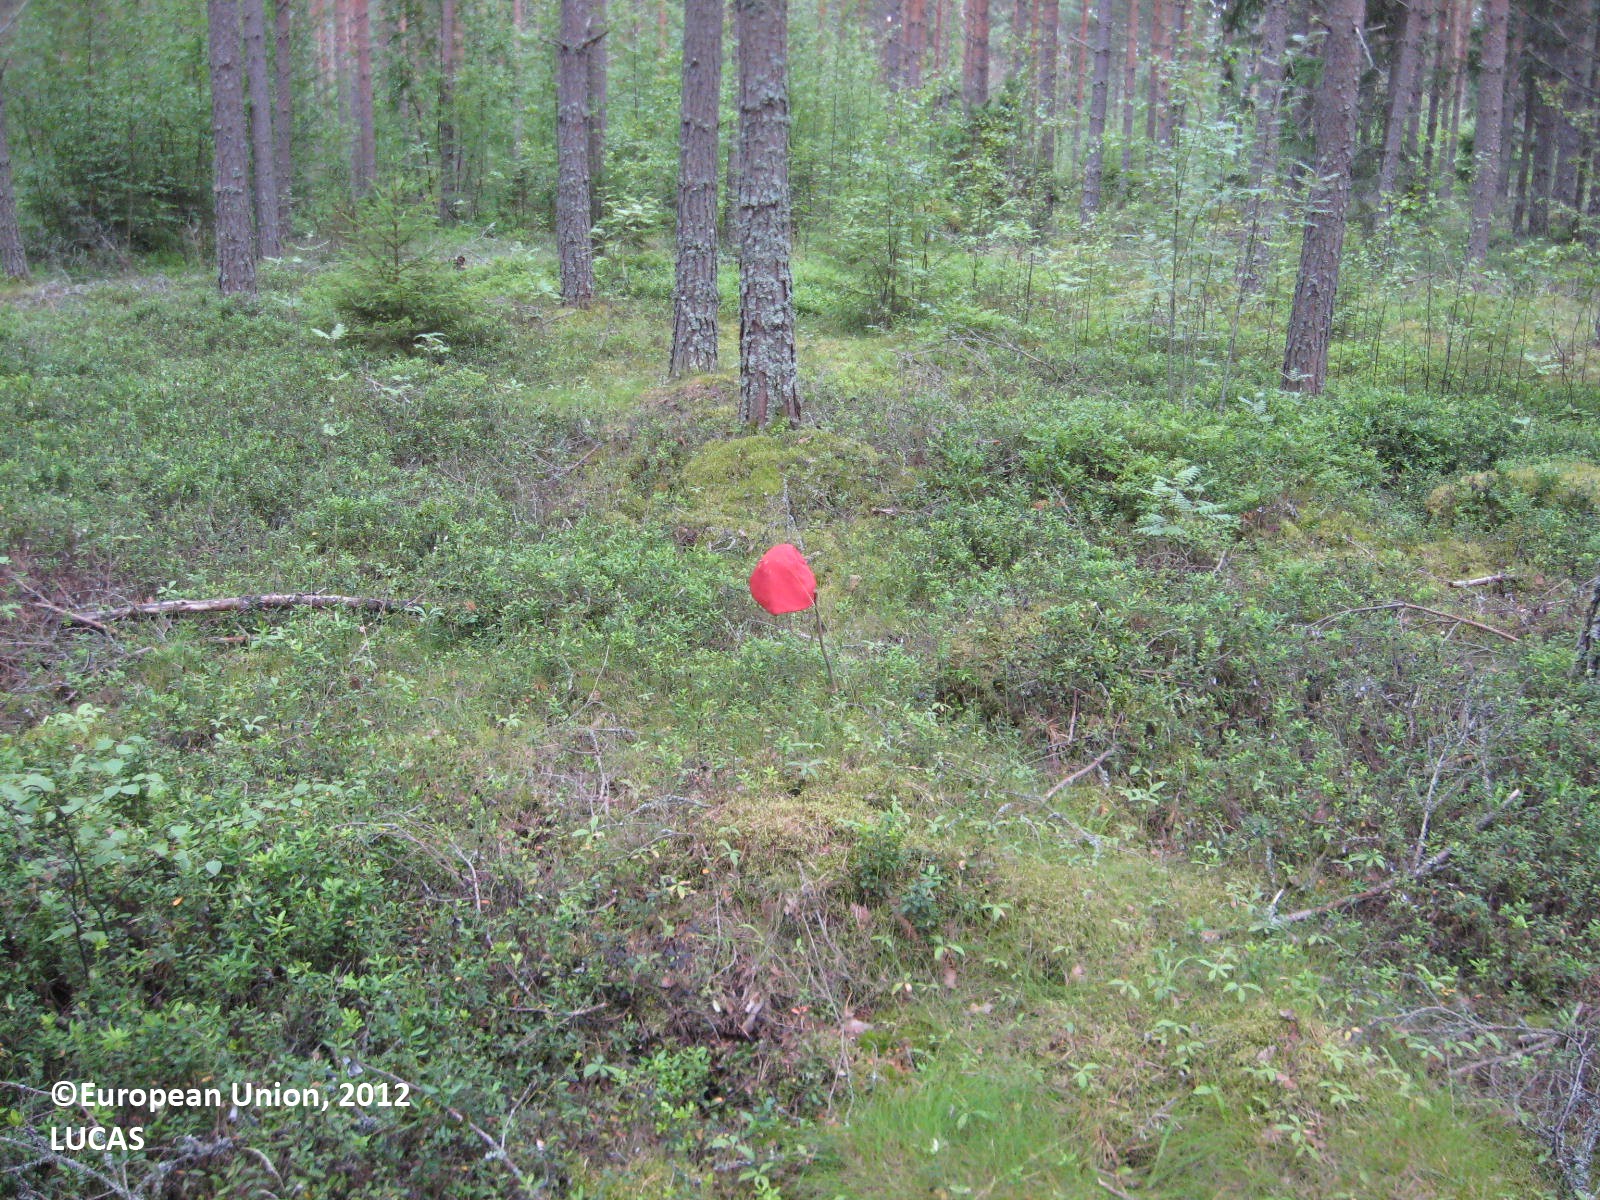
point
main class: Woodland
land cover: Pine dominated coniferous woodland
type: boreal forest
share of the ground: > 75 %
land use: Forestry
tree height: > 5 m
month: July
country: FI
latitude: 62.4854
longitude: 21.1970
